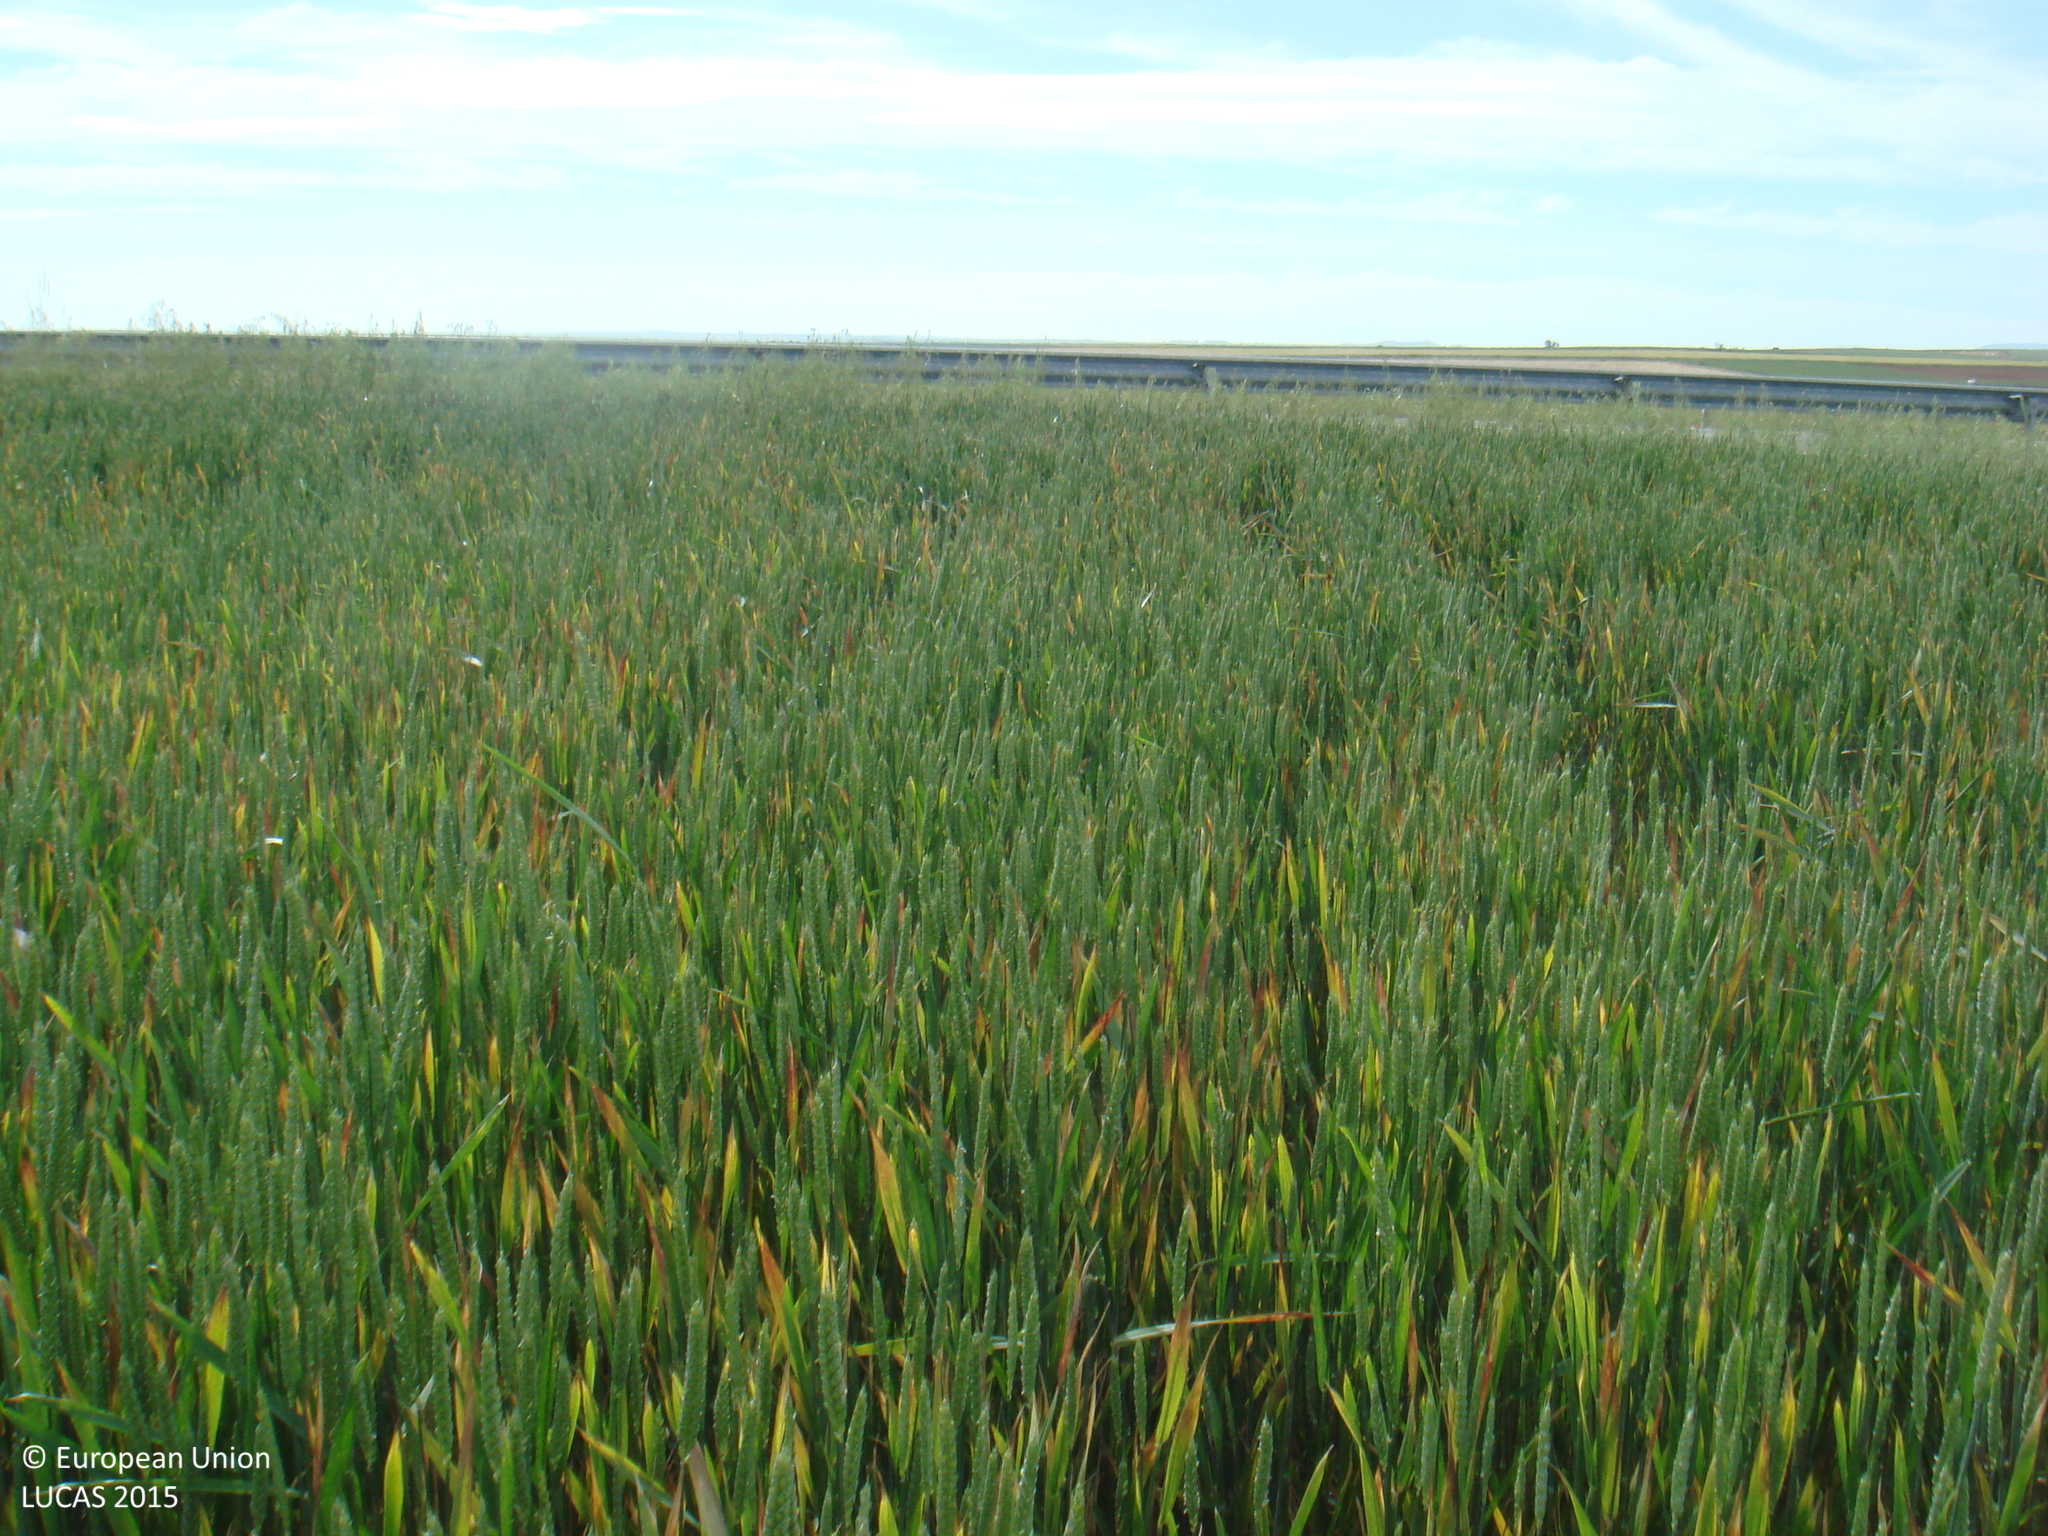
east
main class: Cropland
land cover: Common wheat
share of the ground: > 75 %
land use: Agriculture (excluding fallow land and kitchen gardens)
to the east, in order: Common wheat; Grass margins; Paved roads, cycling and walking lanes; Grass margins; Other bare soil; Grass margins; Spontaneously vegetated surfaces; Grass margins; Other bare soil; Grass margins; Other bare soil
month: May
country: ES
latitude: 38.4591
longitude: -5.1447
